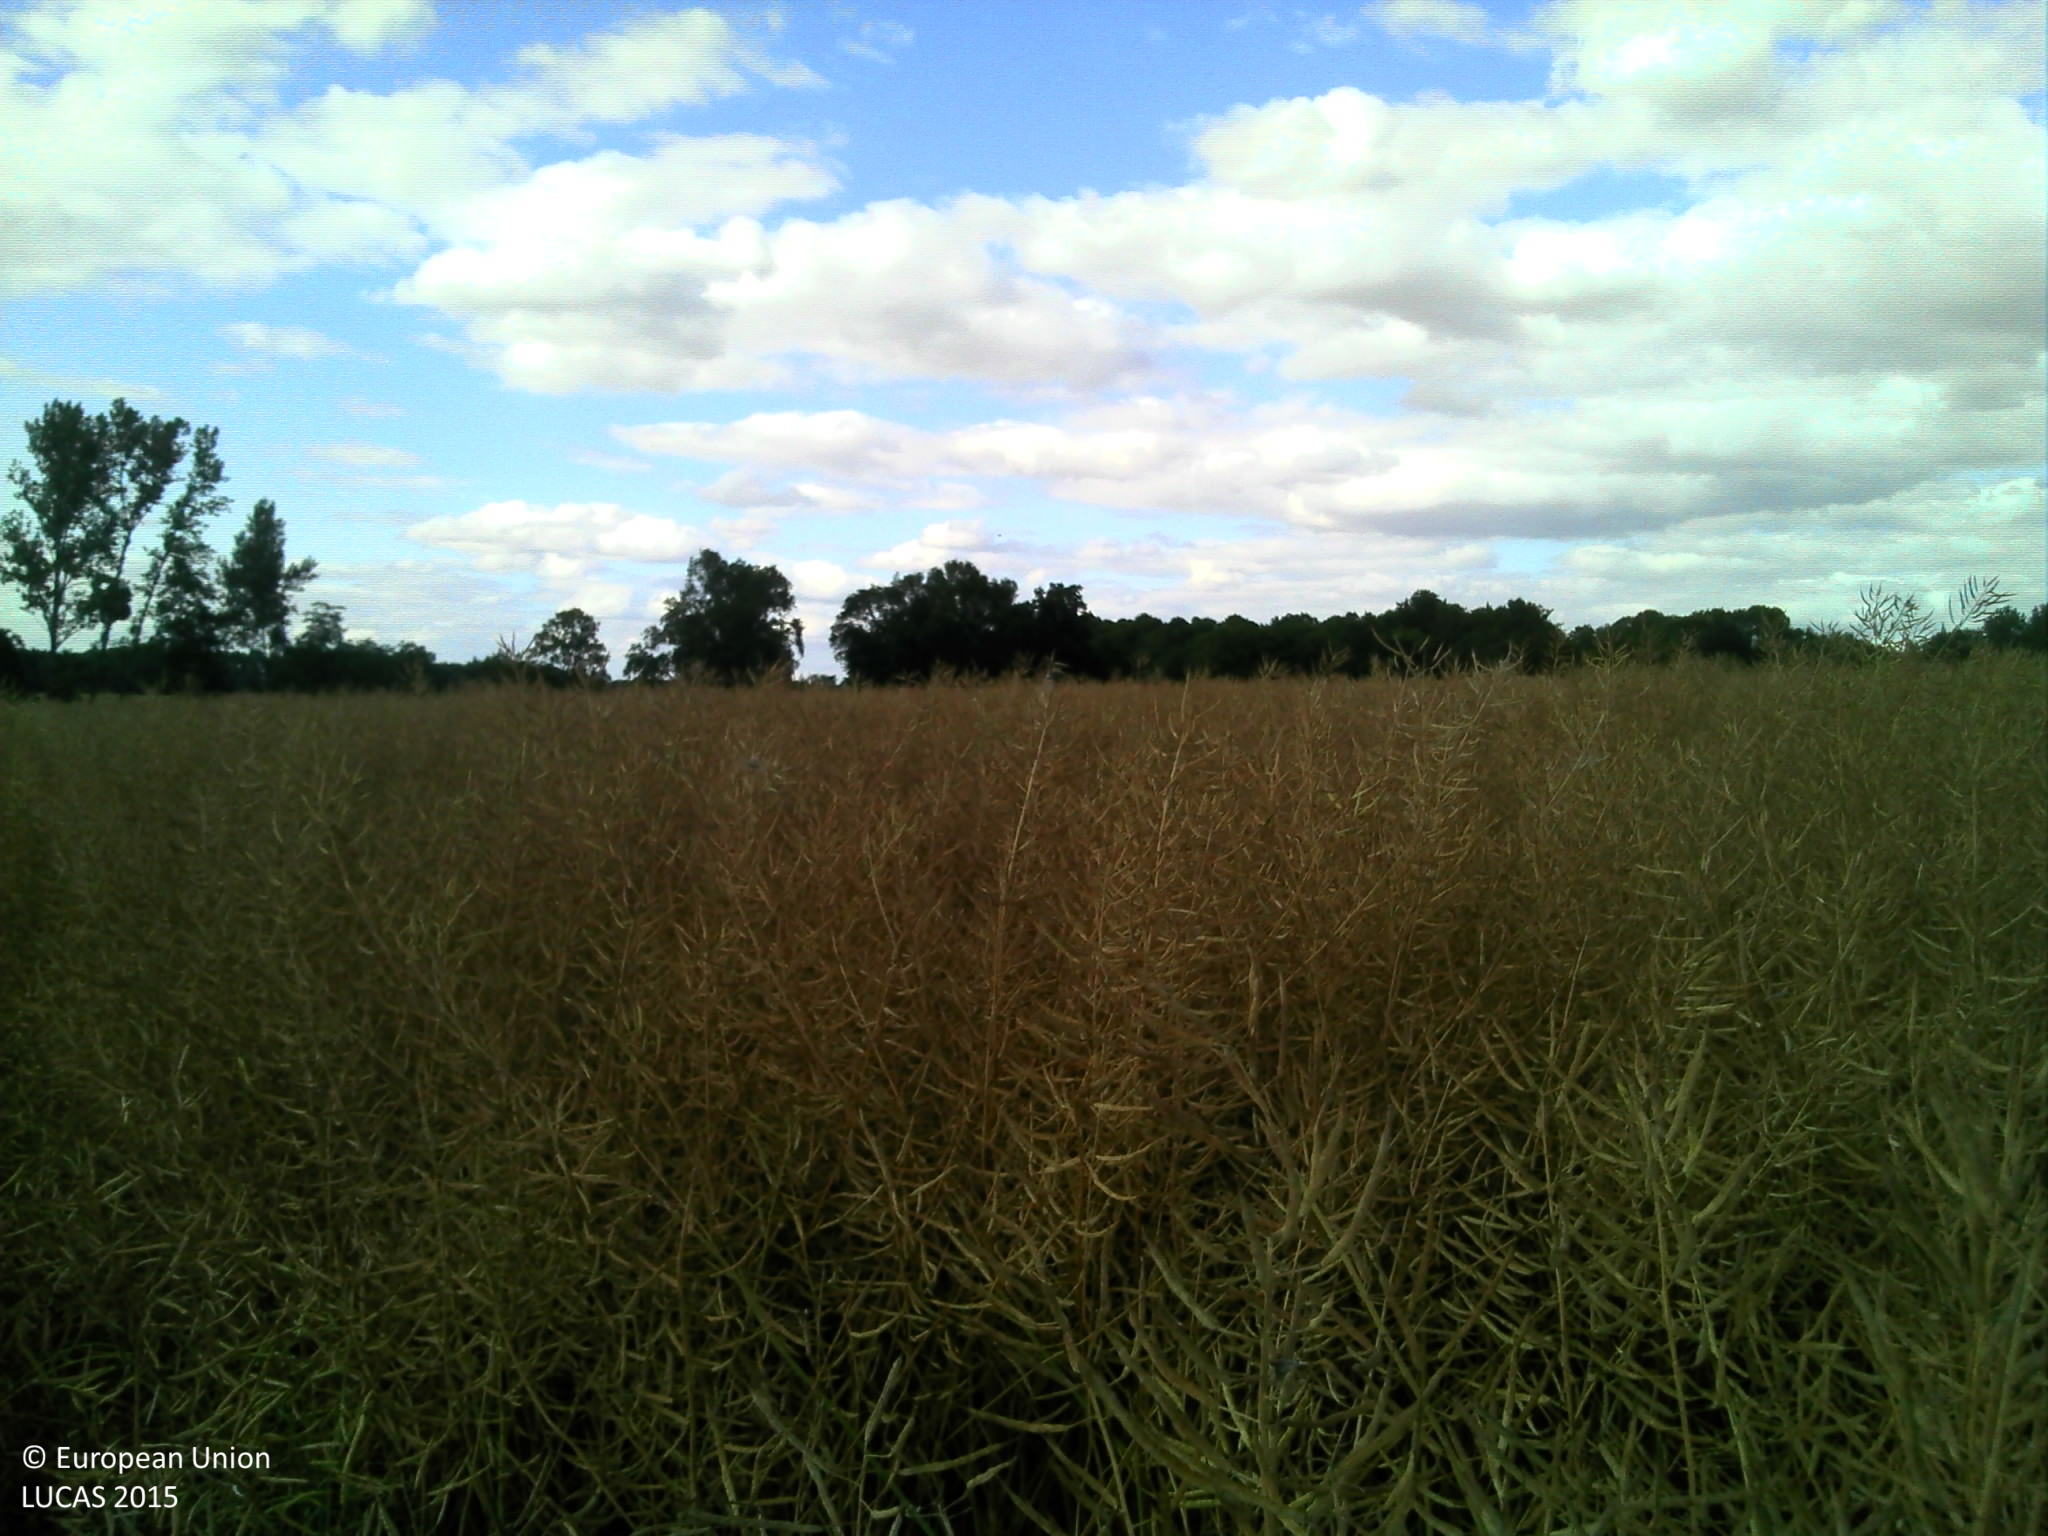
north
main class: Cropland
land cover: Rape and turnip rape
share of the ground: > 75 %
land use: Agriculture (excluding fallow land and kitchen gardens)
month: July
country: FR
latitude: 48.9628
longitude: 5.1220
